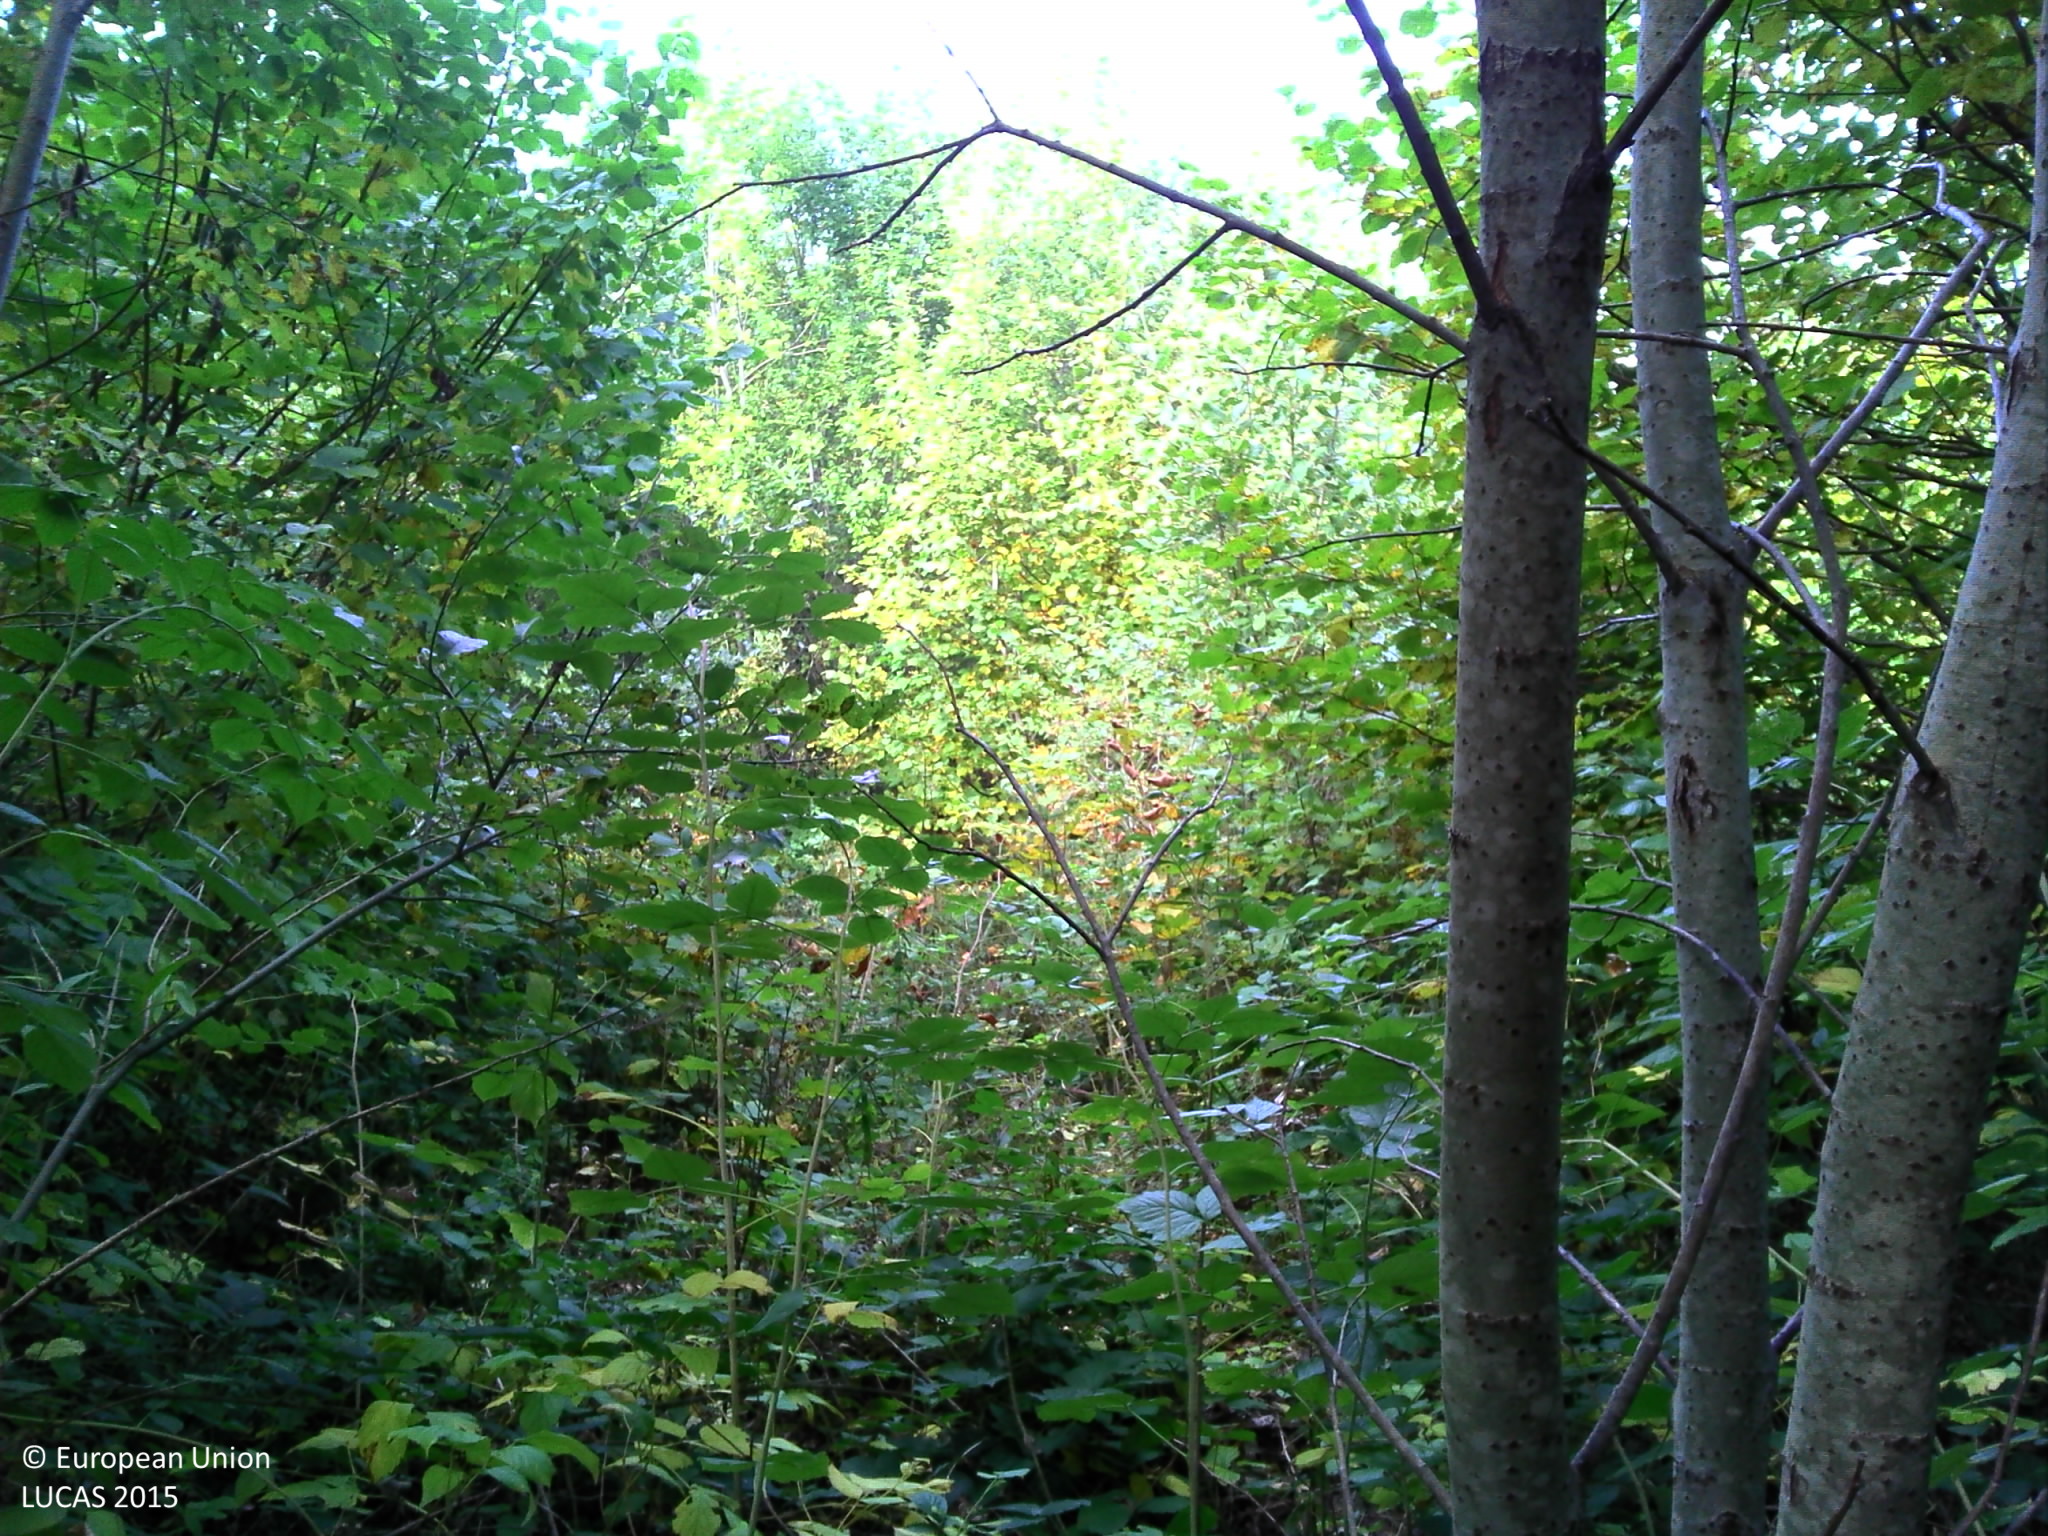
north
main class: Woodland
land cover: Broadleaved woodland
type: mesophytic deciduous forest
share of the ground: 50 - 75 %
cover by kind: broadleaved forest trees 75 %, shrubs 25 %
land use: Forestry
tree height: > 5 m
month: October
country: FR
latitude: 47.0283
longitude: 6.3574
